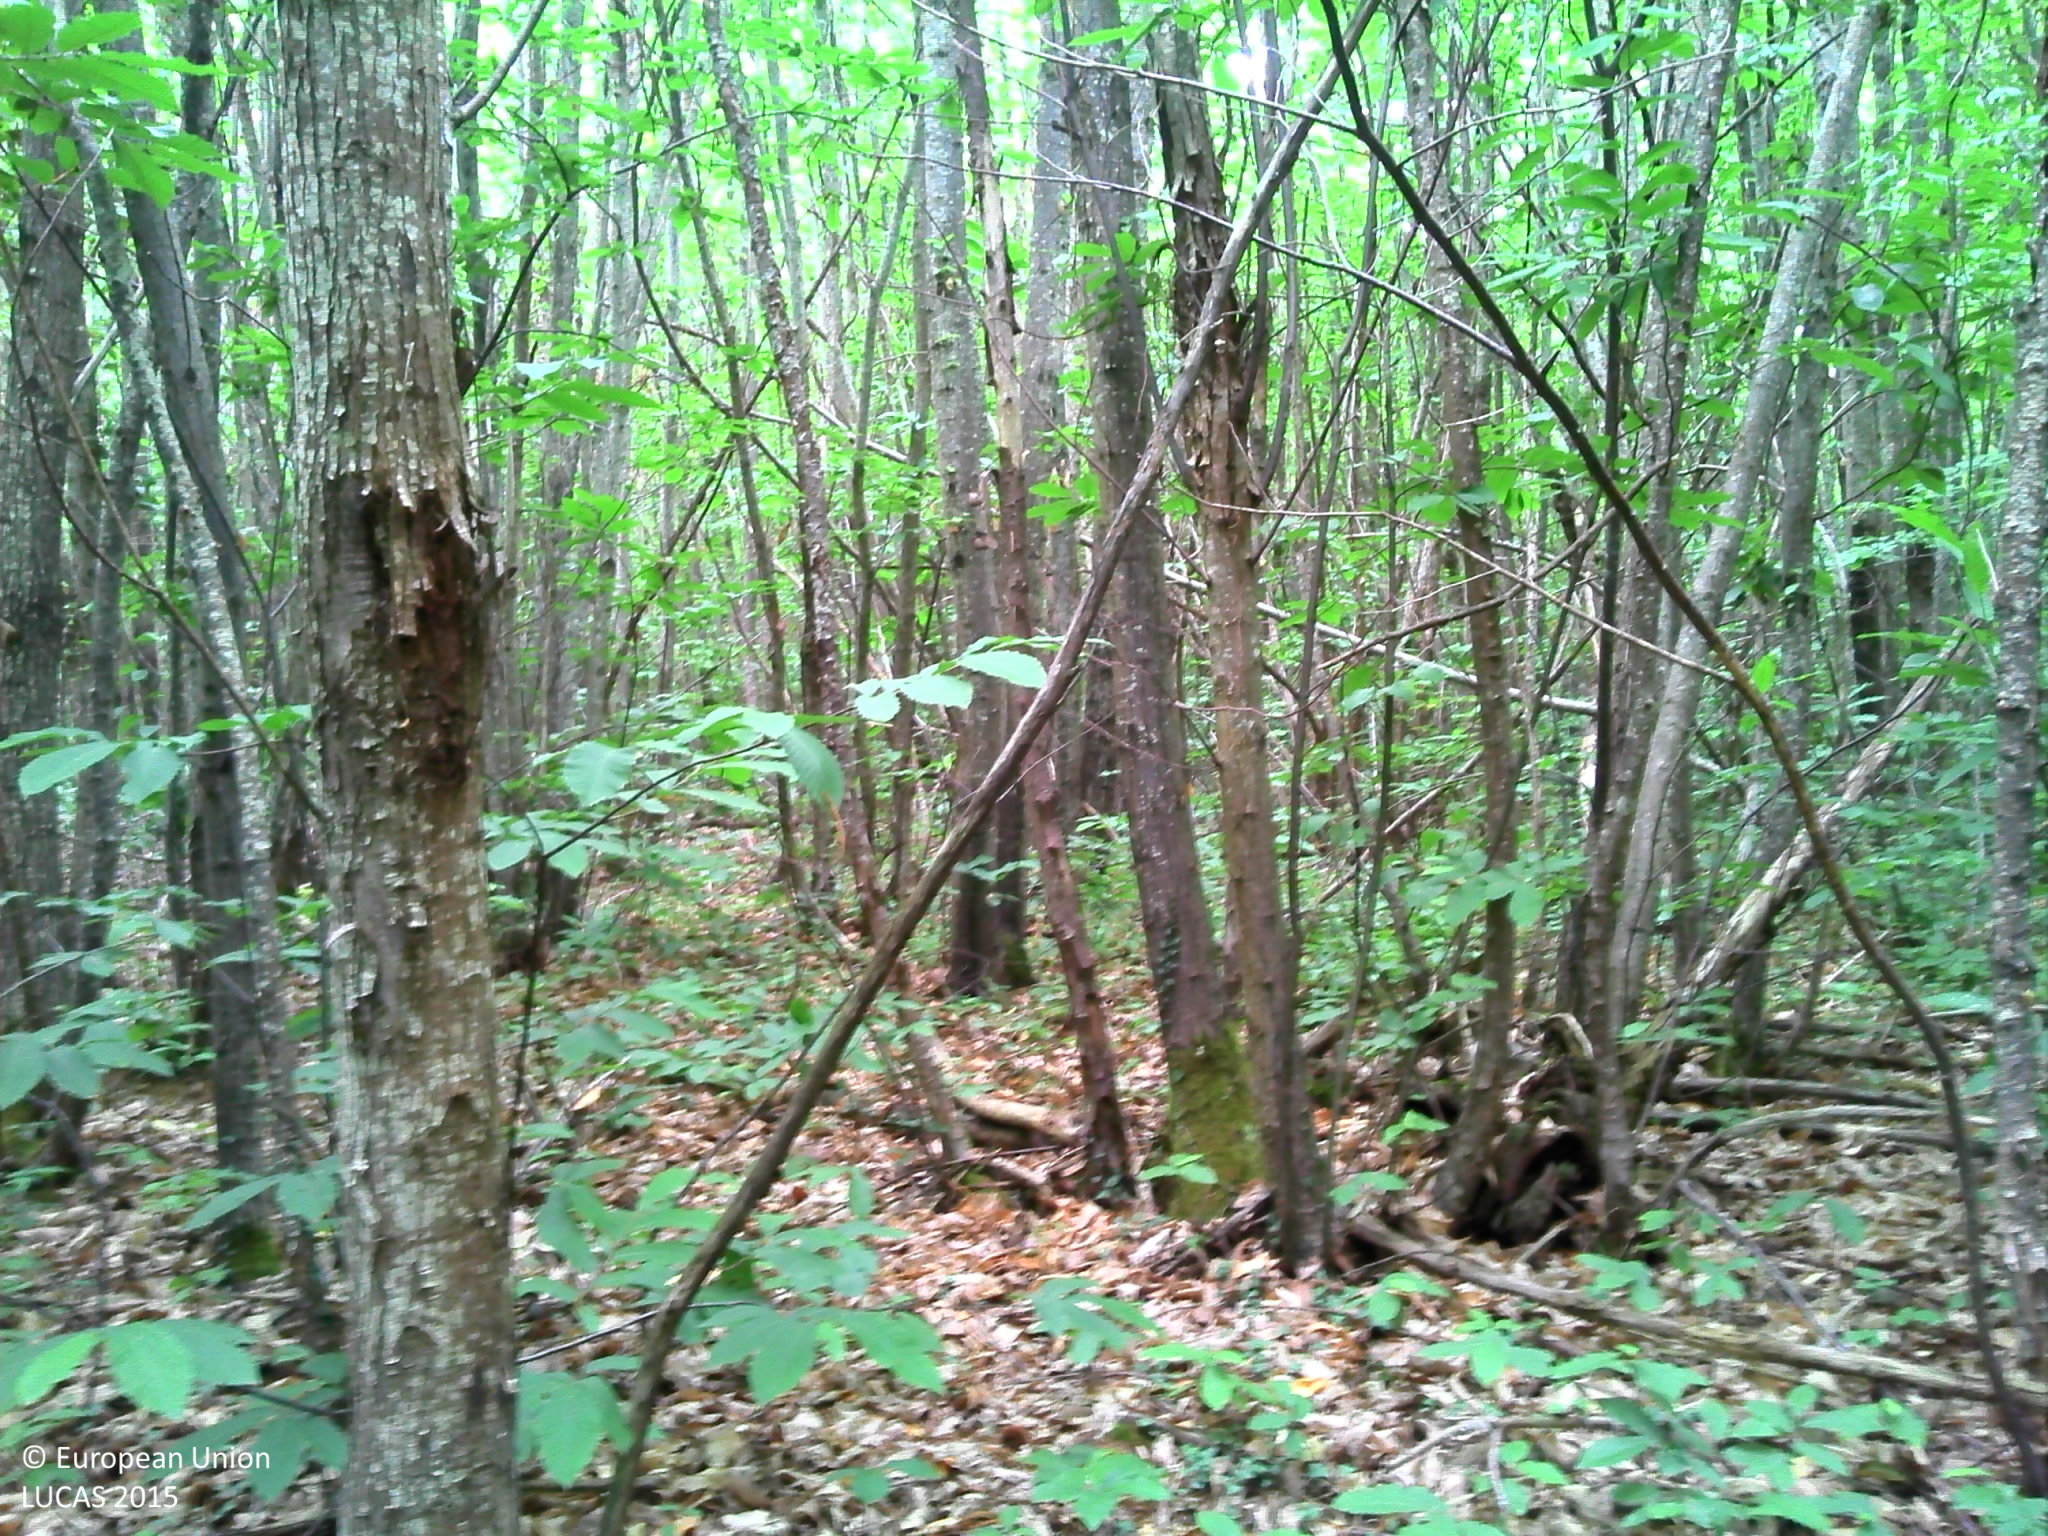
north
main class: Woodland
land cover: Broadleaved woodland
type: thermophilous deciduous forest
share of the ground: > 75 %
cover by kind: broadleaved forest trees 80 %, herbaceous plants 10 %, shrubs 5 %, lichens and mosses 5 %
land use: Forestry
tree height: > 5 m
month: August
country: FR
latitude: 44.6998
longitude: 0.9708
